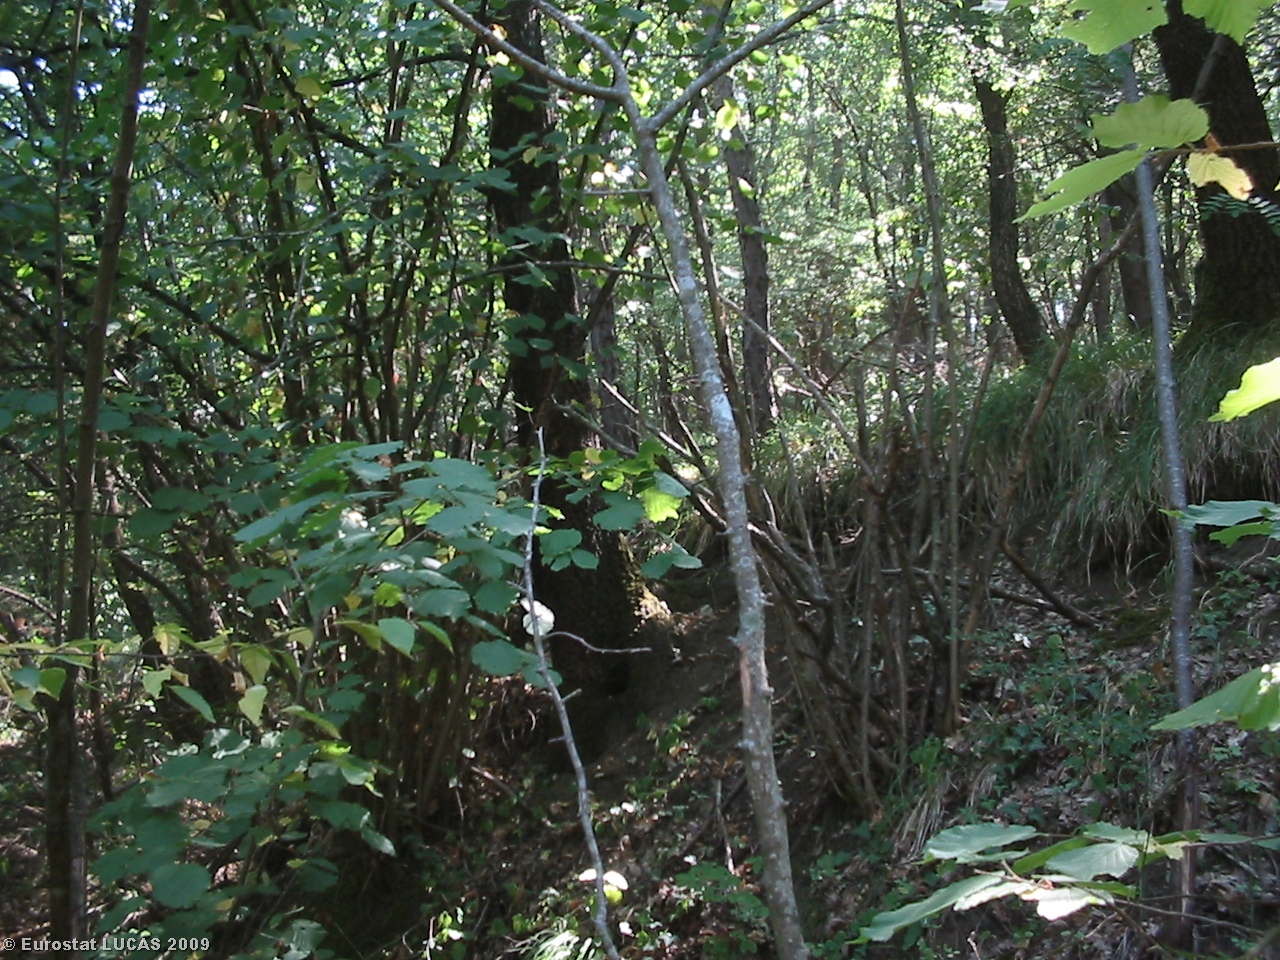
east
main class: Woodland
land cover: Mixed woodland
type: thermophilous deciduous forest
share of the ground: > 75 %
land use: Forestry
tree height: > 5 m
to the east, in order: Mixed woodland; Arable land (only in case pi); Abandoned hedges; Grassland with sparse tree/shrub cover
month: July
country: IT
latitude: 44.4582
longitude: 10.3386
